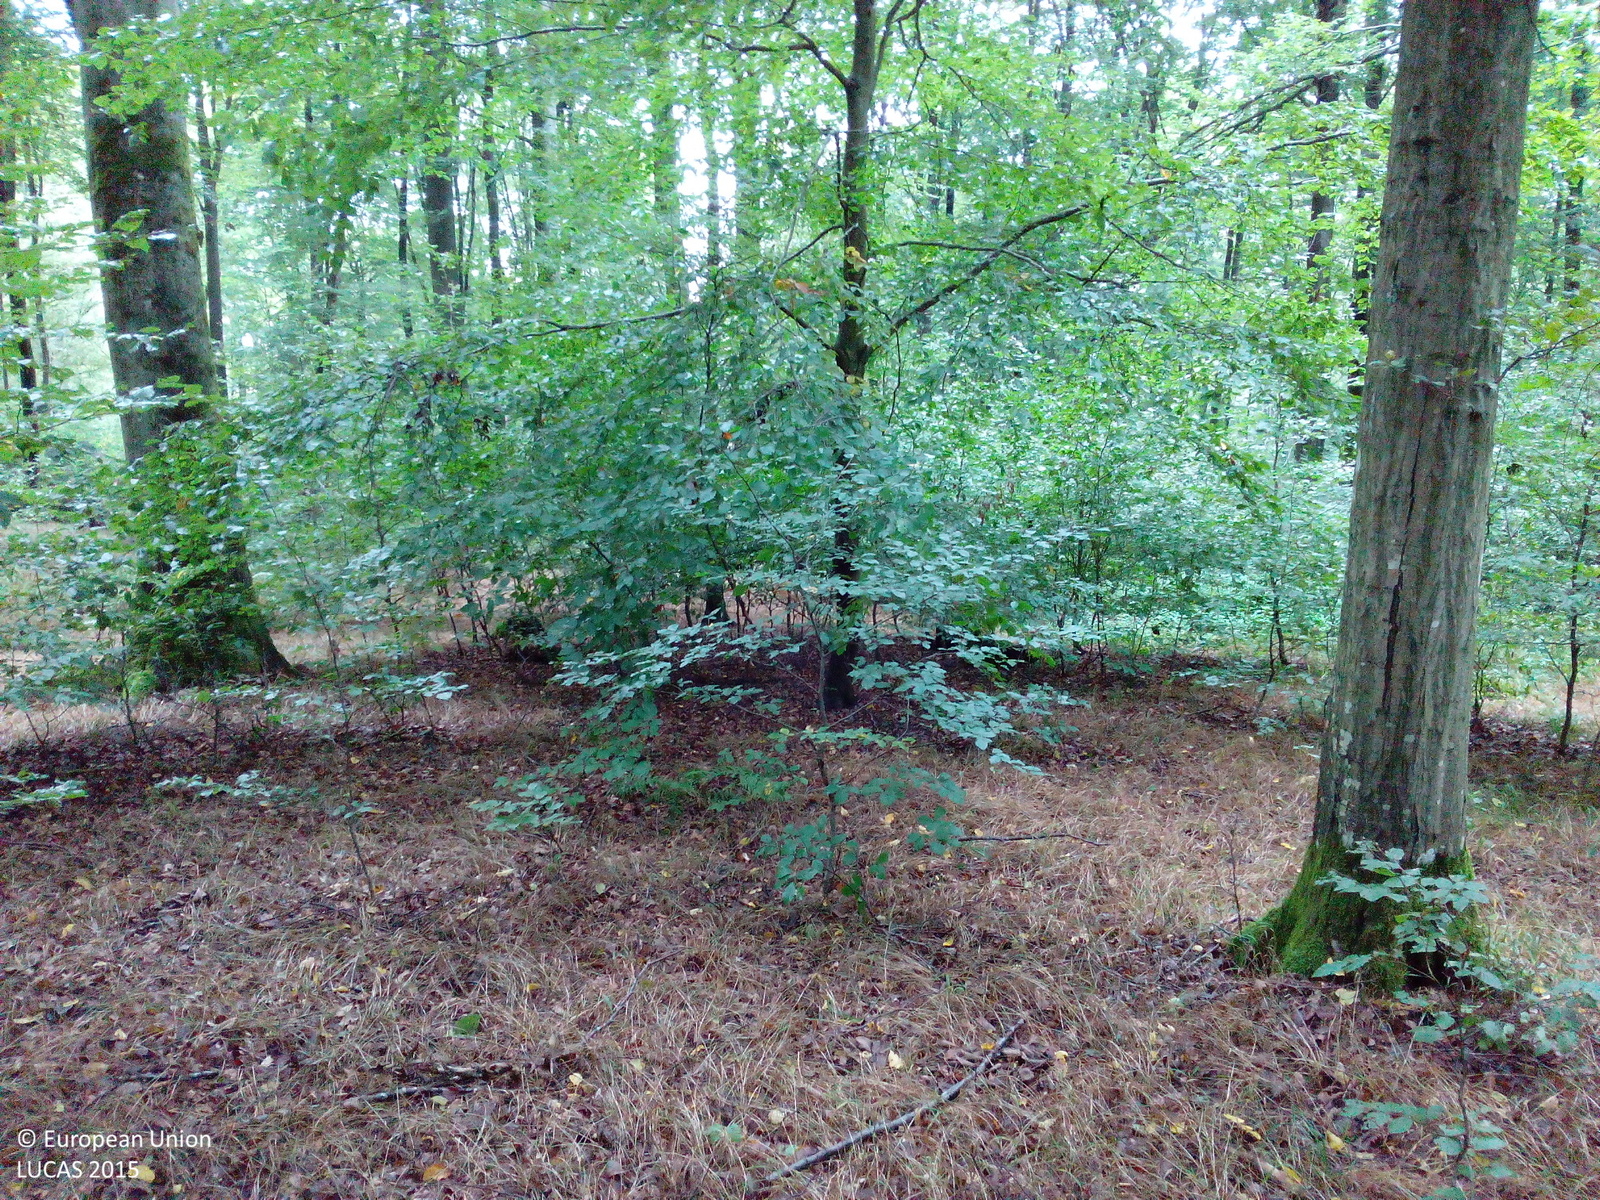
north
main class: Woodland
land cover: Broadleaved woodland
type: beech forest
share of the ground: > 75 %
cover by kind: broadleaved forest trees 95 %, herbaceous plants 5 %
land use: Forestry
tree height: > 5 m
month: September
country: DE
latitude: 49.9145
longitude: 9.9582
